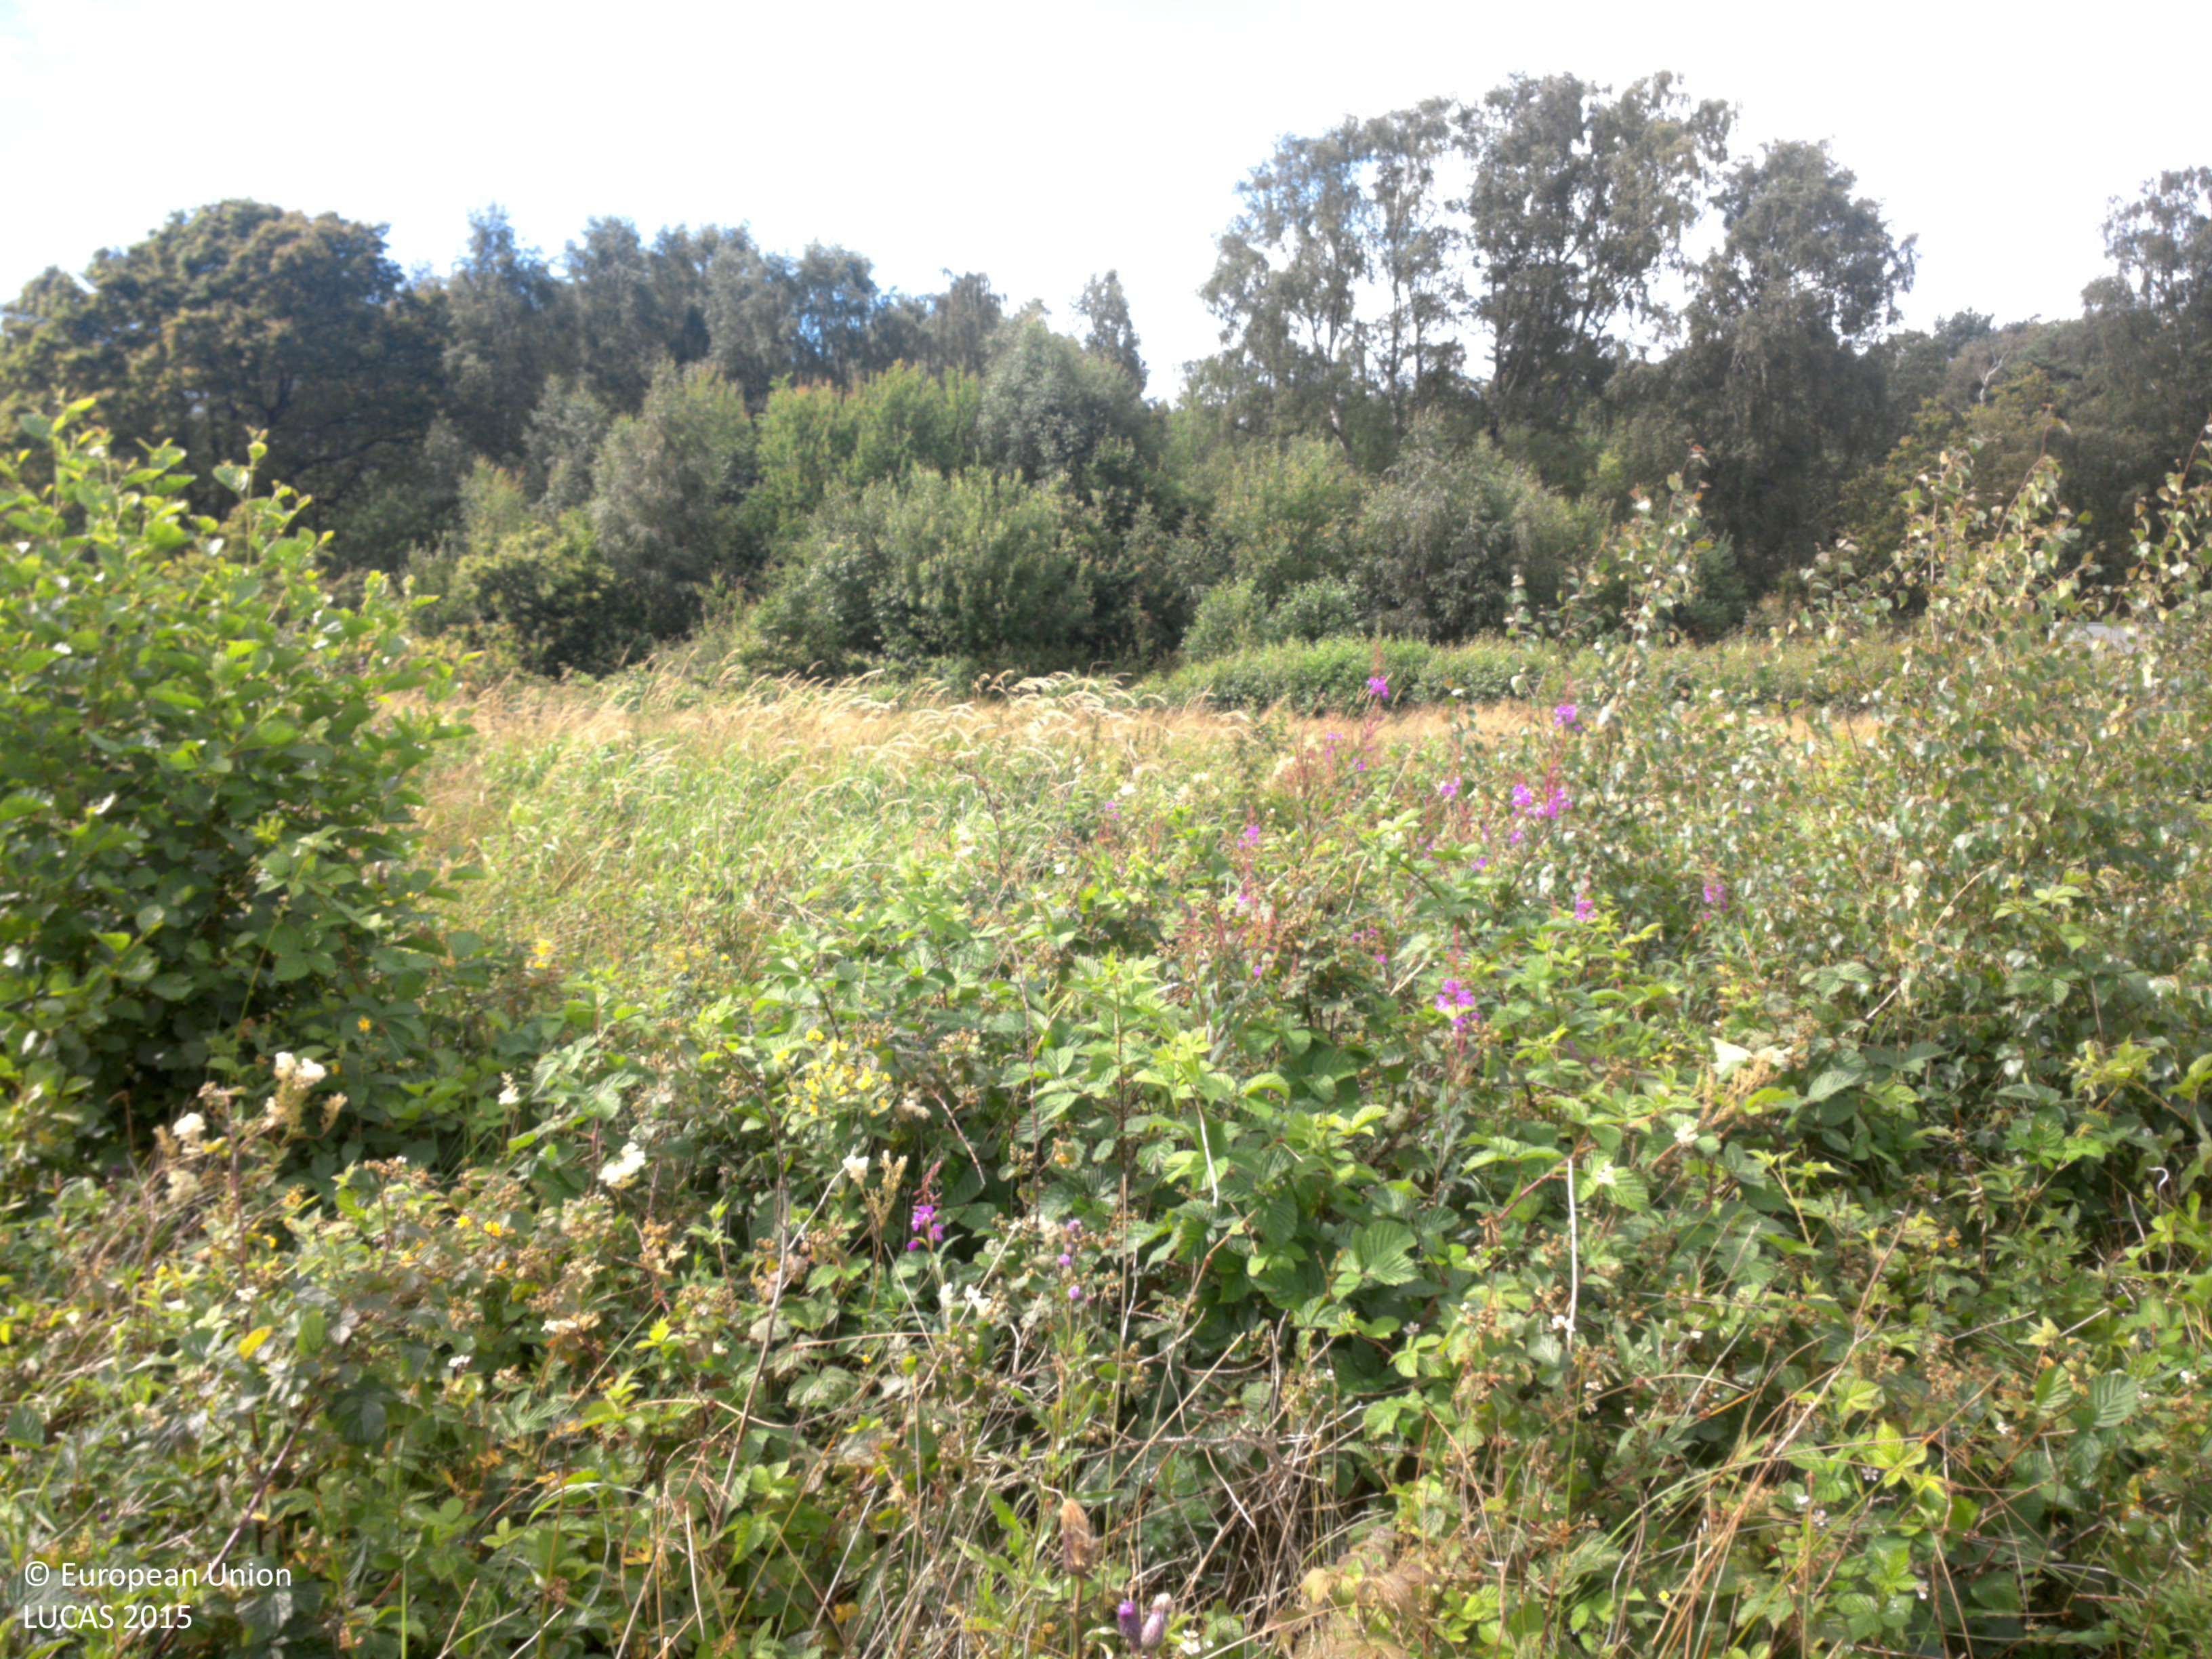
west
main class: Woodland
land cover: Broadleaved woodland
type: hemiboreal forest and nemoral coniferous forest and mixed broadleaved-coniferous forest
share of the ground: 25 - 50 %
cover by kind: broadleaved forest trees 45 %, herbaceous plants 30 %, shrubs 25 %
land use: Semi-natural and natural areas not in use
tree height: < 5 m
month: July
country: SE
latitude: 58.0809
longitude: 11.8449
